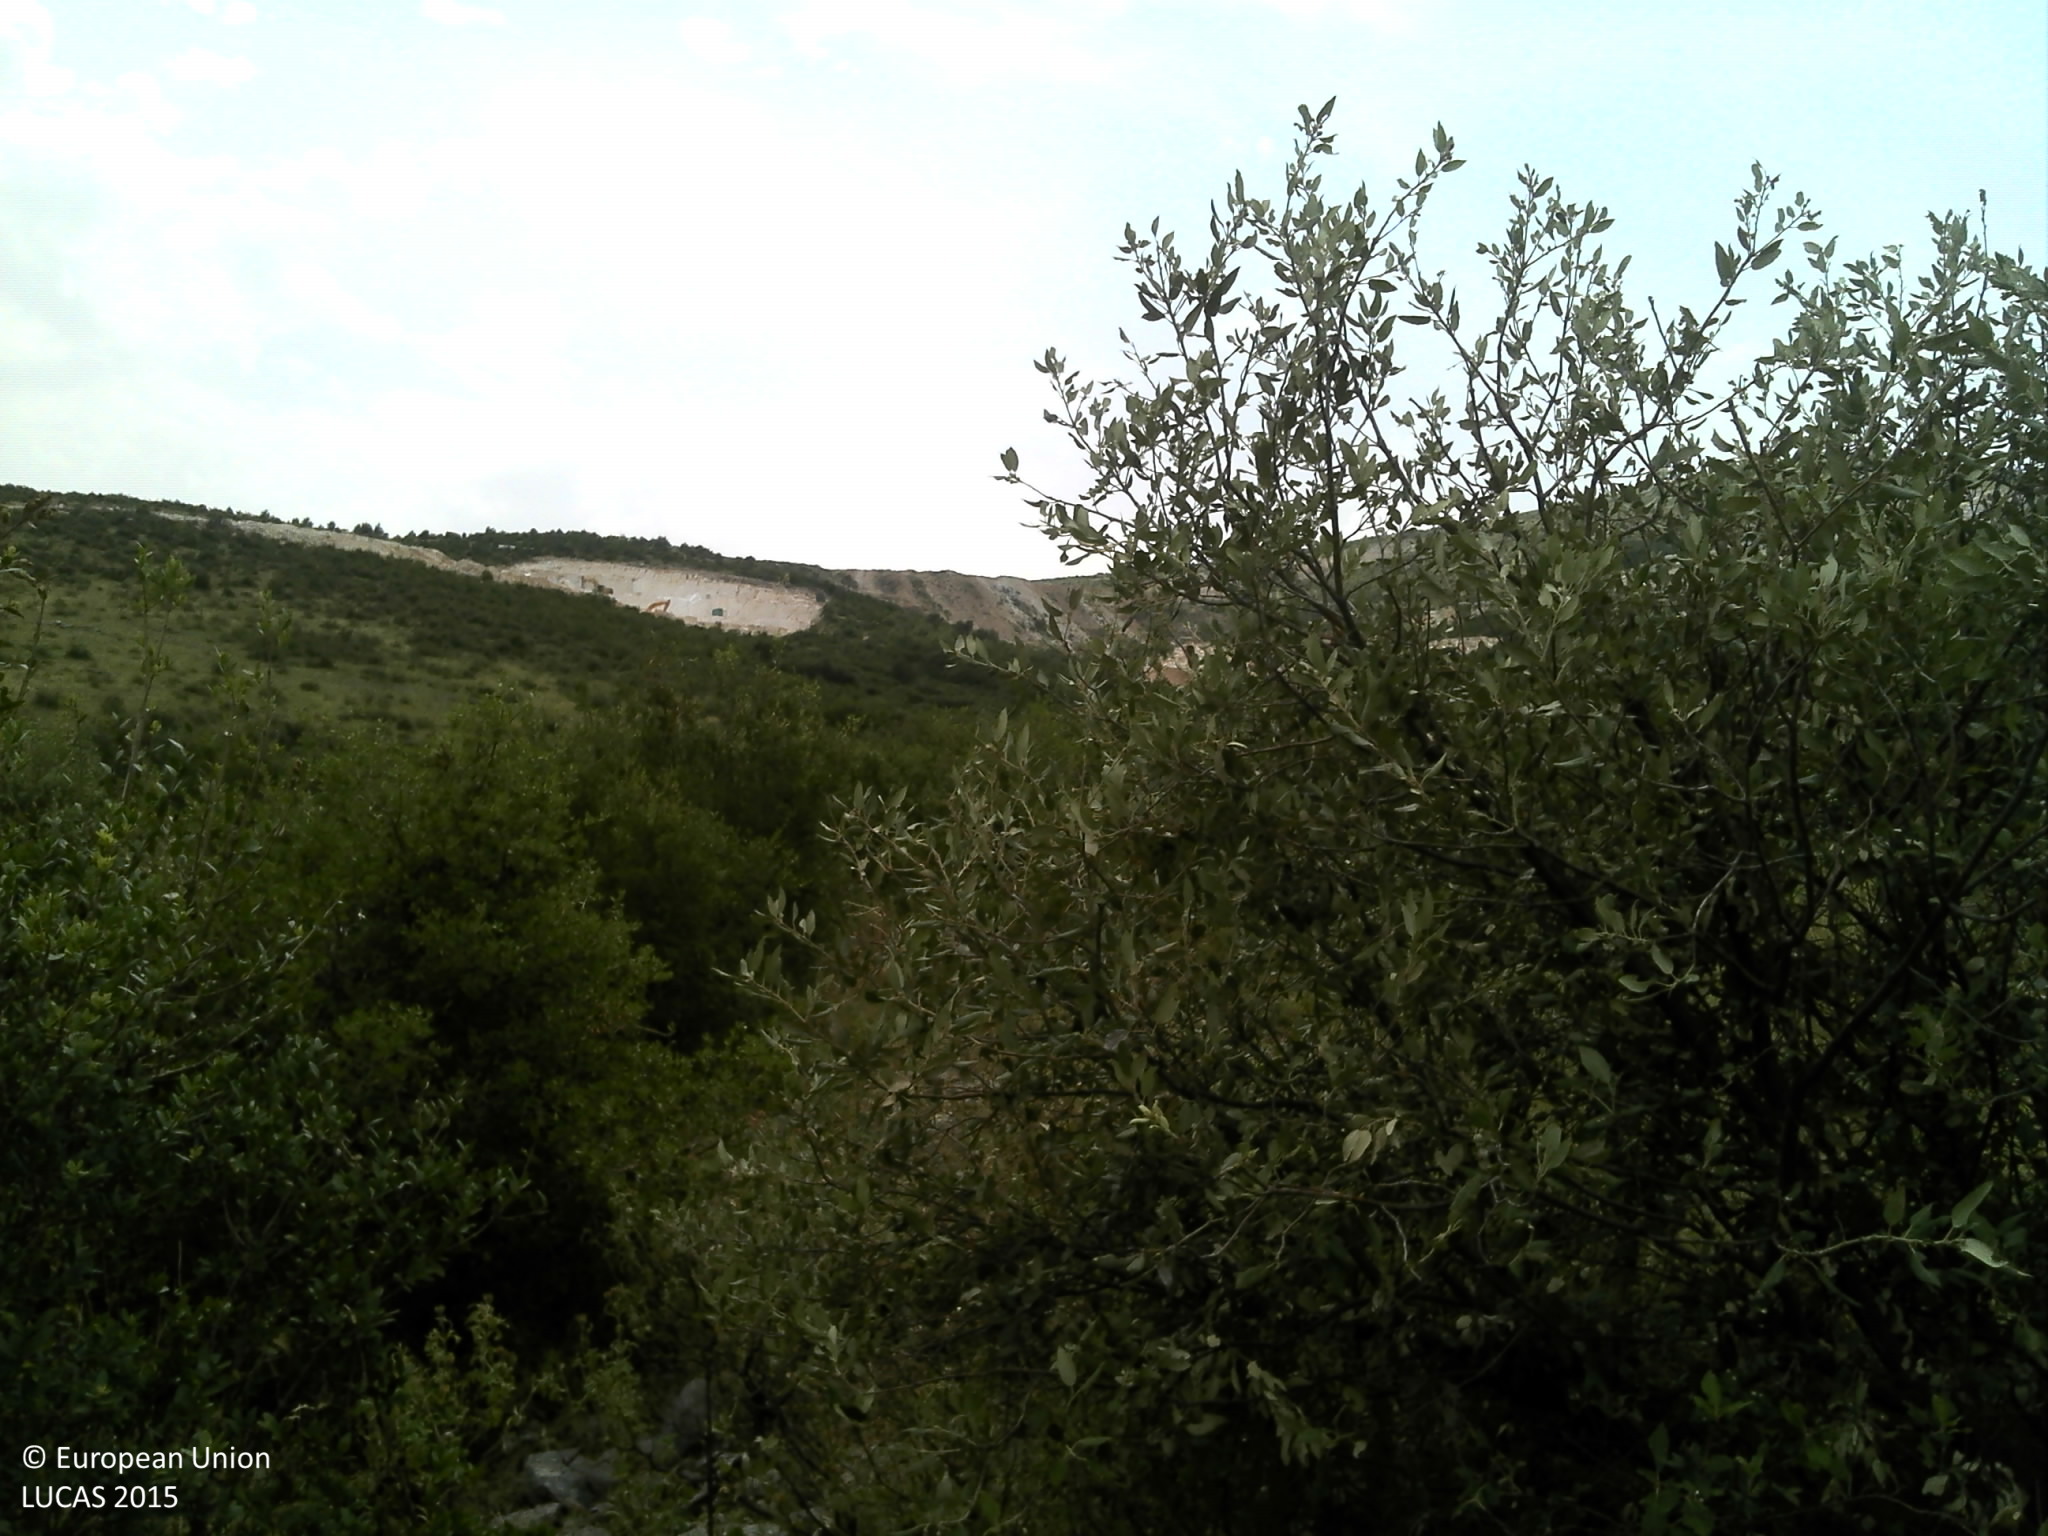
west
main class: Shrubland
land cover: Shrubland without tree cover
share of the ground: 50 - 75 %
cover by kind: shrubs 50 %, herbaceous plants 20 %, consolidated bare surface 15 %, unconsolidated bare surface 15 %
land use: Semi-natural and natural areas not in use
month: June
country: HR
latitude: 43.5461
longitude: 16.2658
